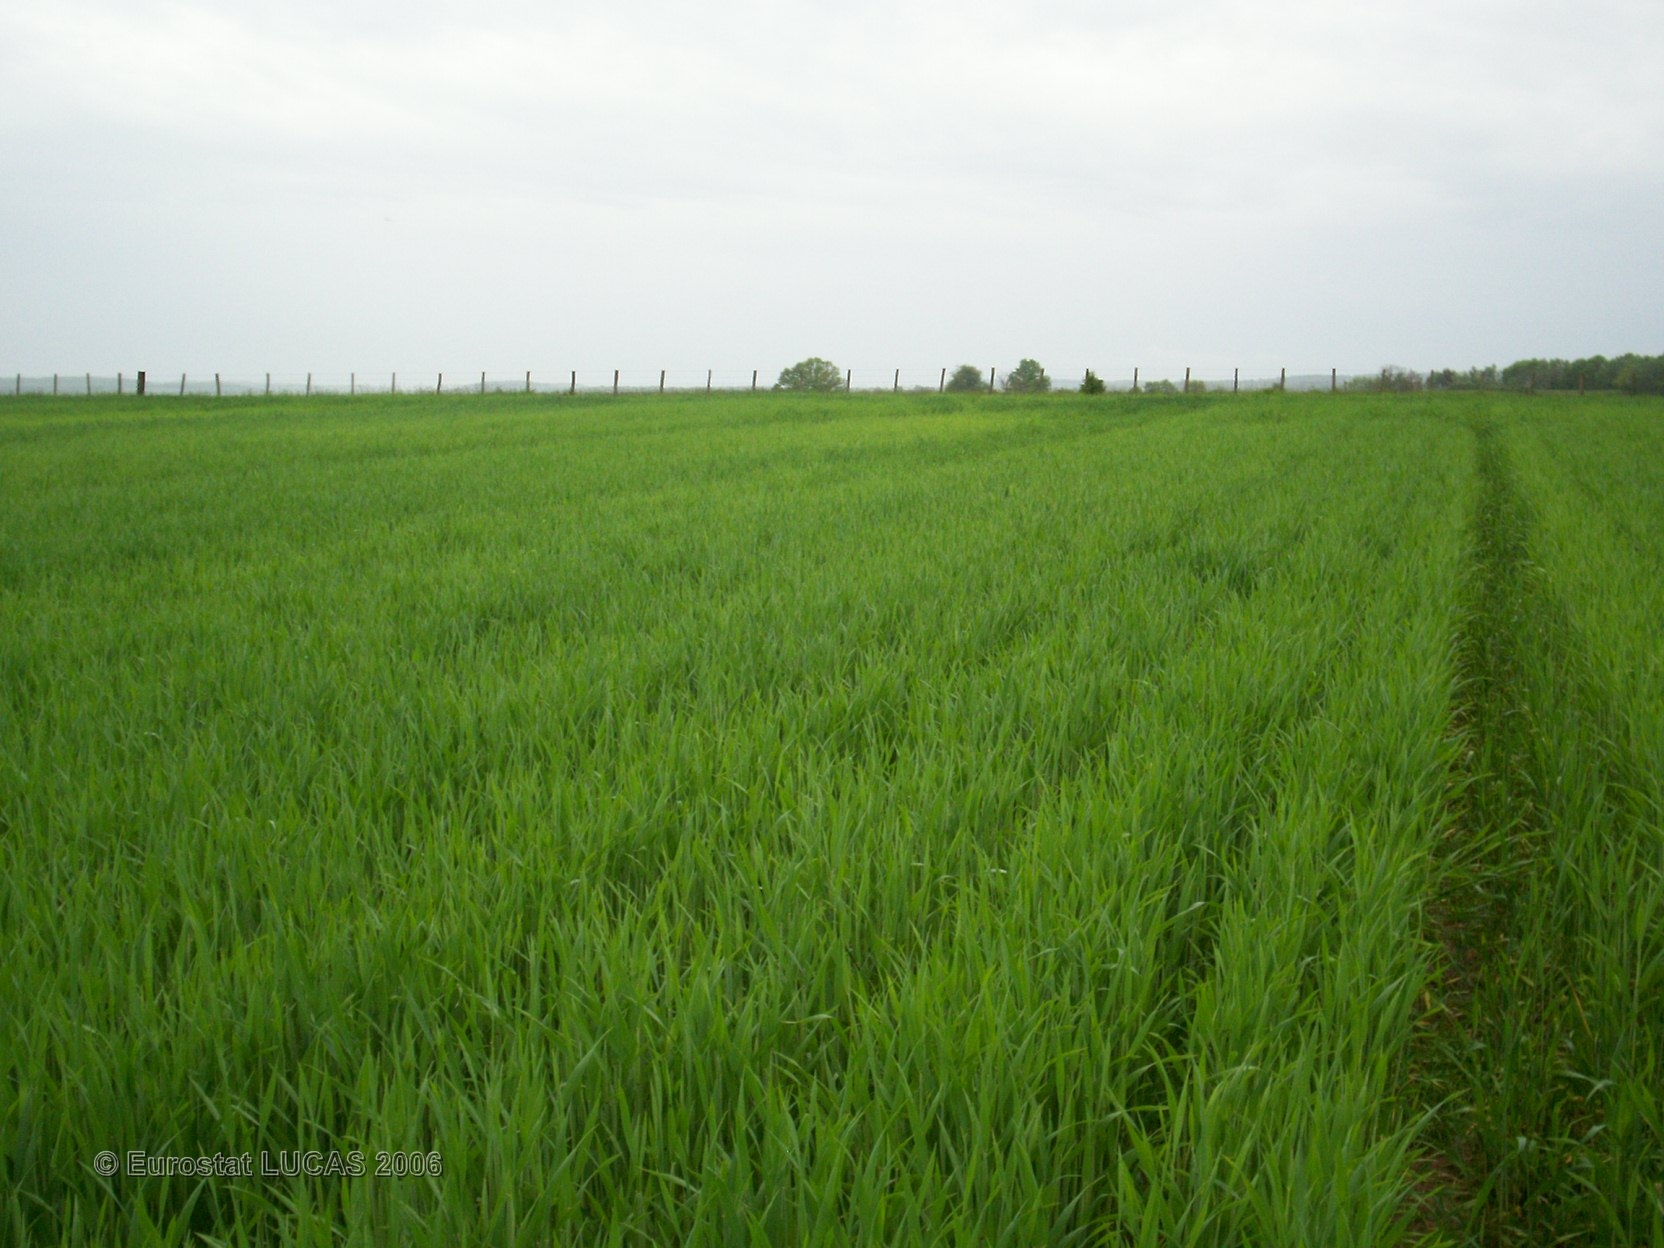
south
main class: Cropland
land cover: Barley
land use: Agriculture (excluding fallow land and kitchen gardens)
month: May
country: FR
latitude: 47.2253
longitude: 4.5984
